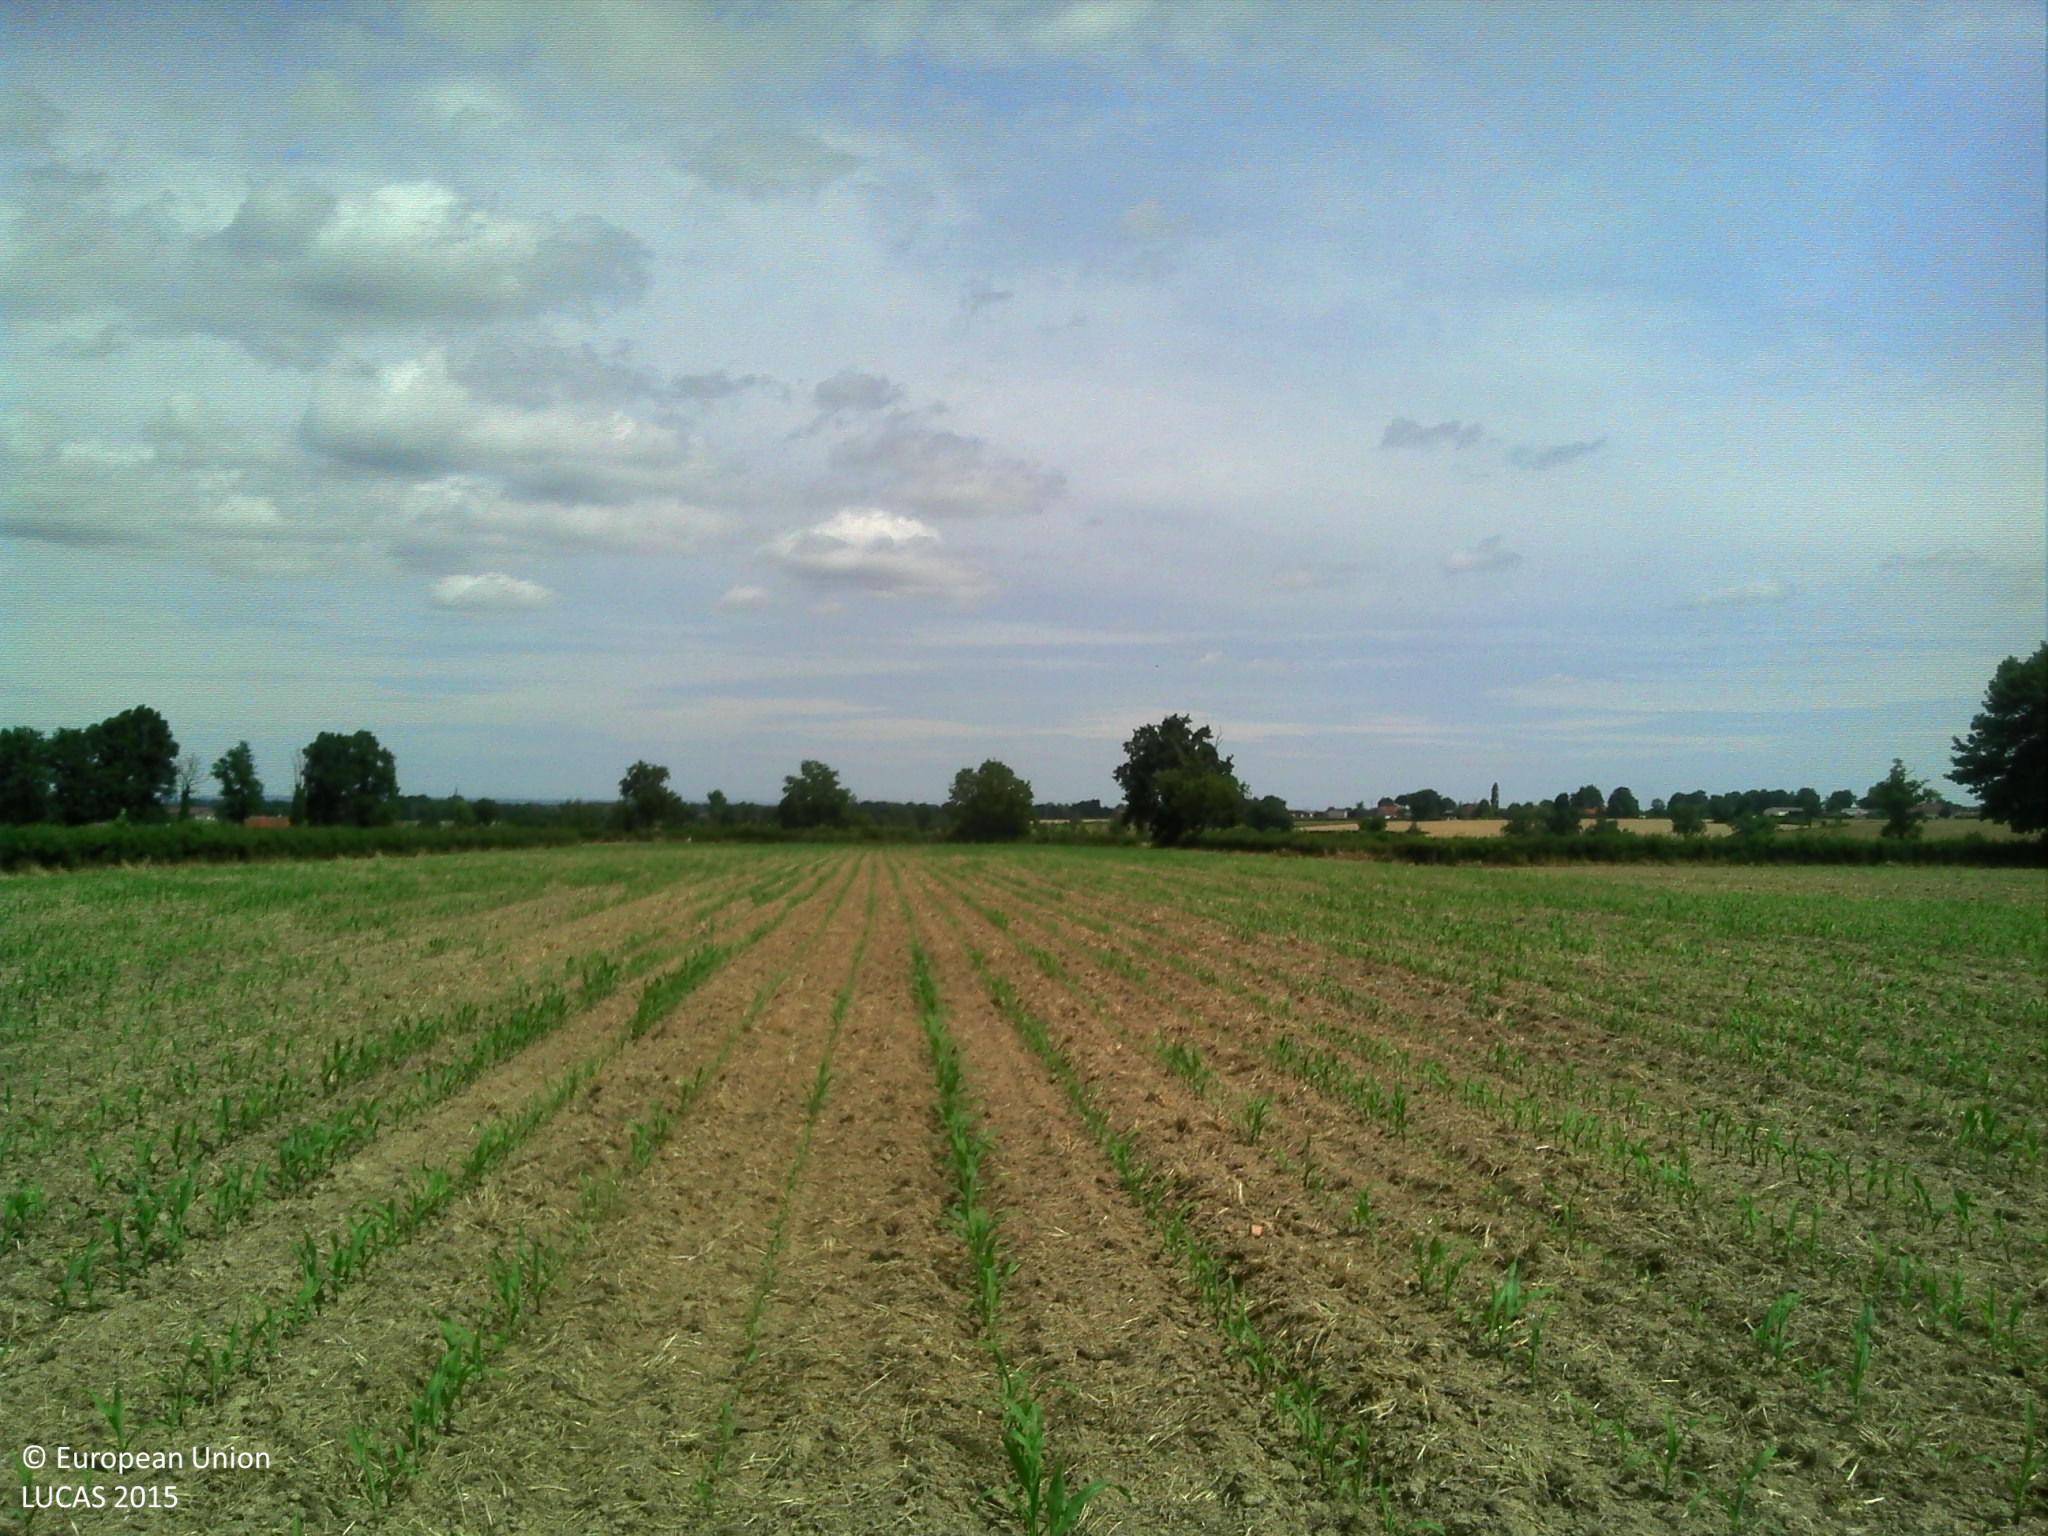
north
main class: Cropland
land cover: Maize
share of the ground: 10 - 25 %
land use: Agriculture (excluding fallow land and kitchen gardens)
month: June
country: FR
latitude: 46.2935
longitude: 4.0425
